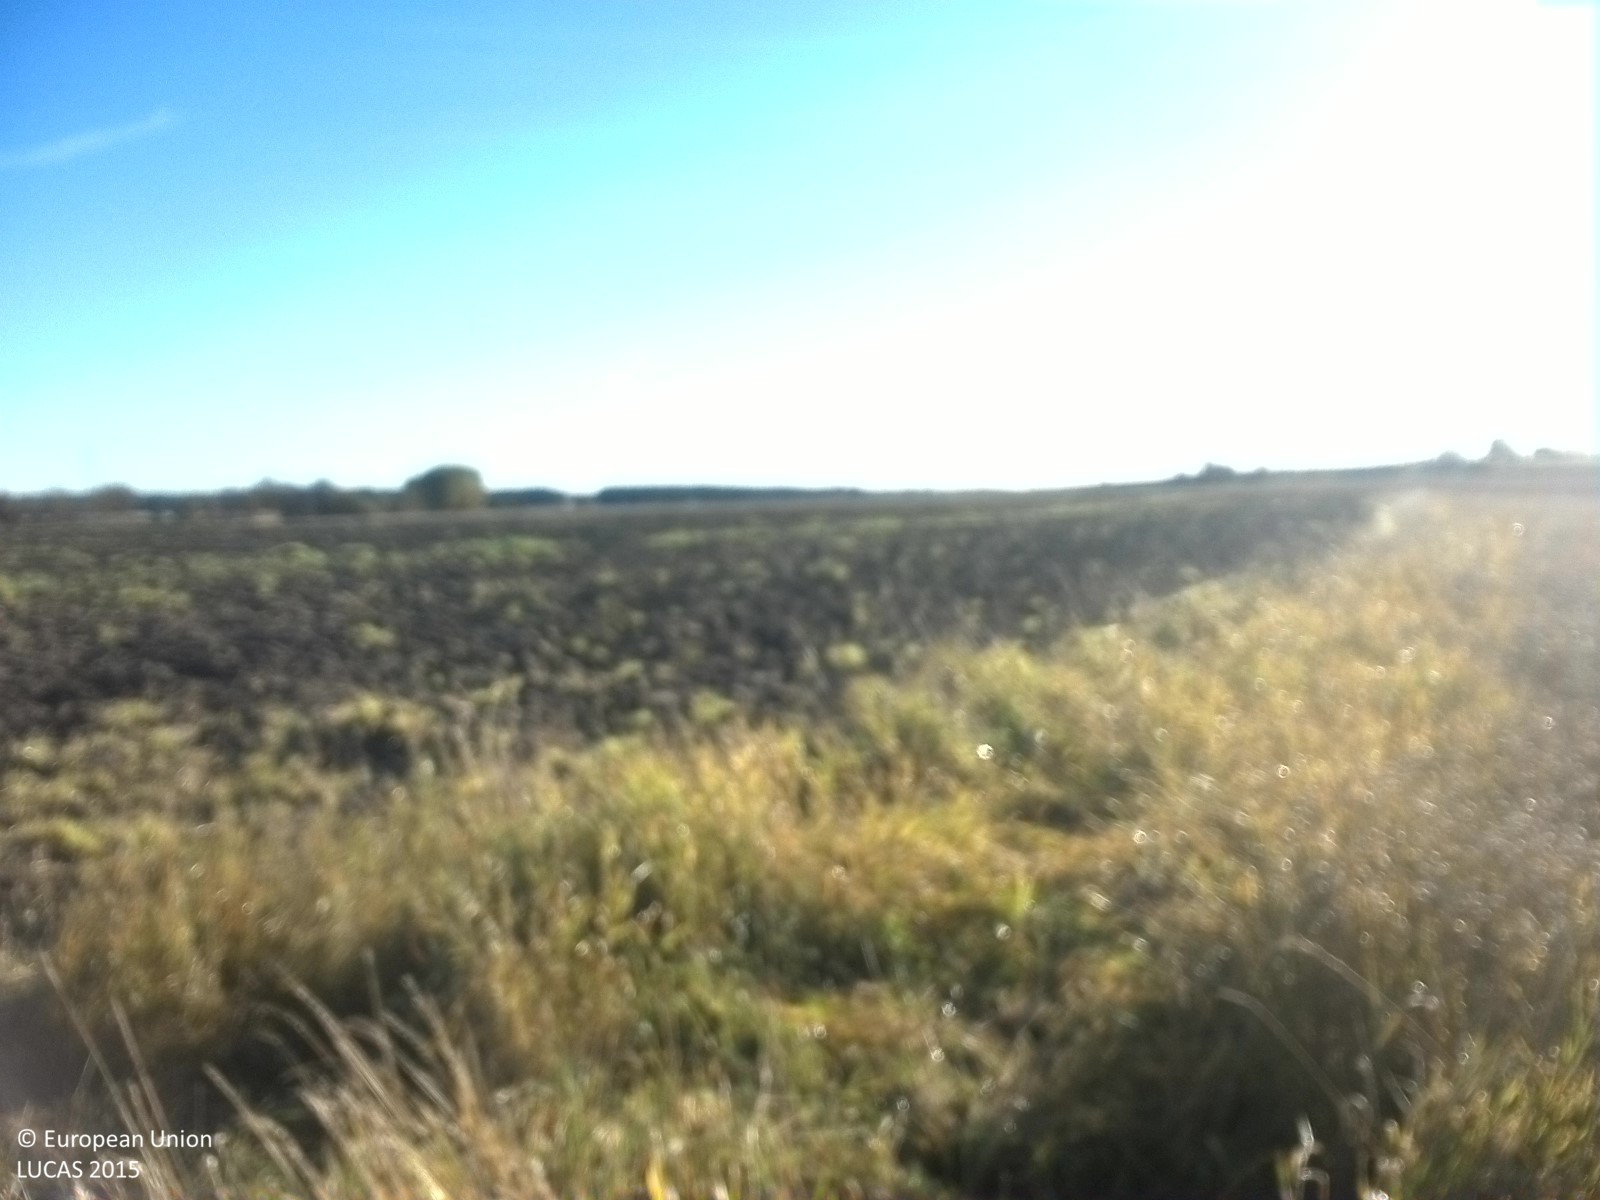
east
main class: Cropland
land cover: Common wheat
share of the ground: > 75 %
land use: Agriculture (excluding fallow land and kitchen gardens)
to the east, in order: Common wheat; Other fibre and oleaginous crops; Electric lines; Other fibre and oleaginous crops
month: September
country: SE
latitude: 58.7540
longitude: 16.7541
